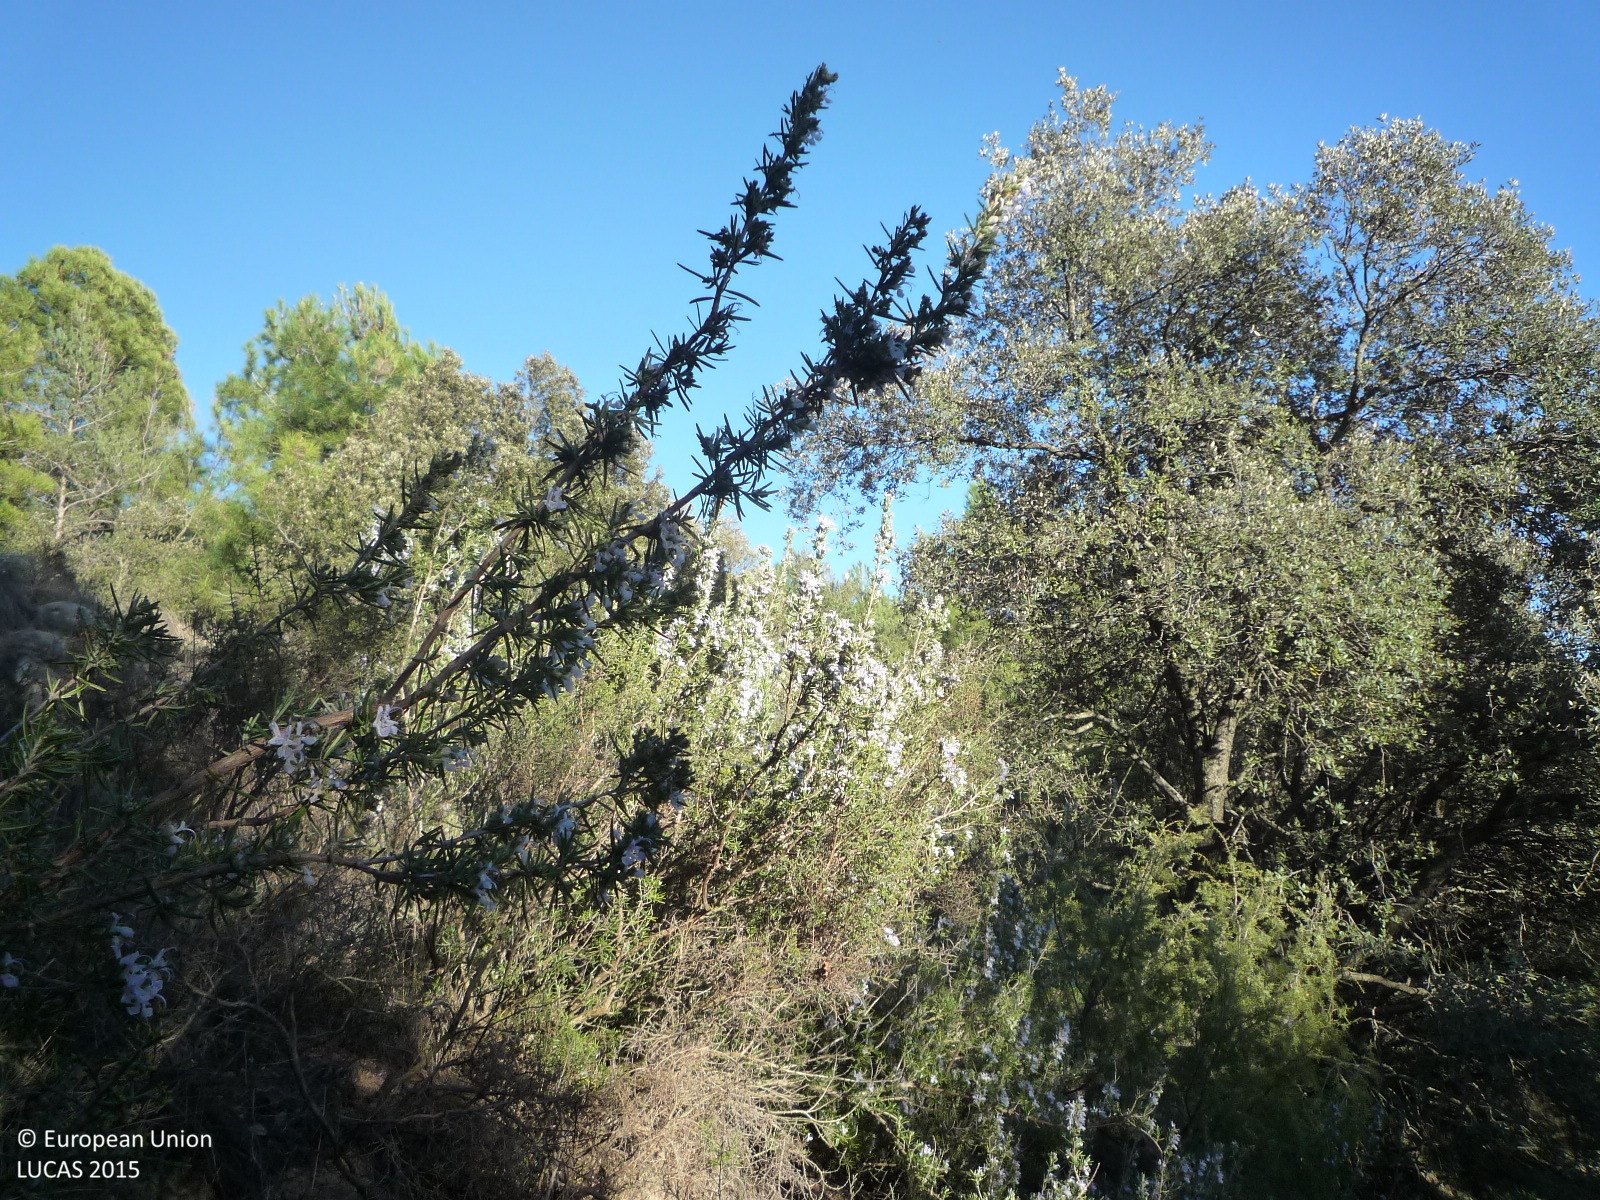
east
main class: Woodland
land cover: Broadleaved woodland
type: broadleaved evergreen forest
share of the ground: > 75 %
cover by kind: broadleaved forest trees 40 %, shrubs 40 %, herbaceous plants 20 %
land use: Semi-natural and natural areas not in use
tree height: < 5 m
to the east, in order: Broadleaved woodland; Dry stone walls; Broadleaved woodland; Pine dominated mixed woodland; Rock outcrops; Pine dominated coniferous woodland; Rock outcrops; Pine dominated coniferous woodland; Dry stone walls; Pine dominated coniferous woodland; Shruby margins; Barley; Pine dominated coniferous woodland; Tracks; Pine dominated coniferous woodland; Rock outcrops; Pine dominated coniferous woodland; Rock outcrops; Pine dominated coniferous woodland; Dry stone walls; Pine dominated coniferous woodland; Dry stone walls; Pine dominated coniferous woodland; Tracks; Pine dominated coniferous woodland; Rock outcrops; Pine dominated coniferous woodland; Dry stone walls; Pine dominated coniferous woodland
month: March
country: ES
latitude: 42.0418
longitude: 1.7134
